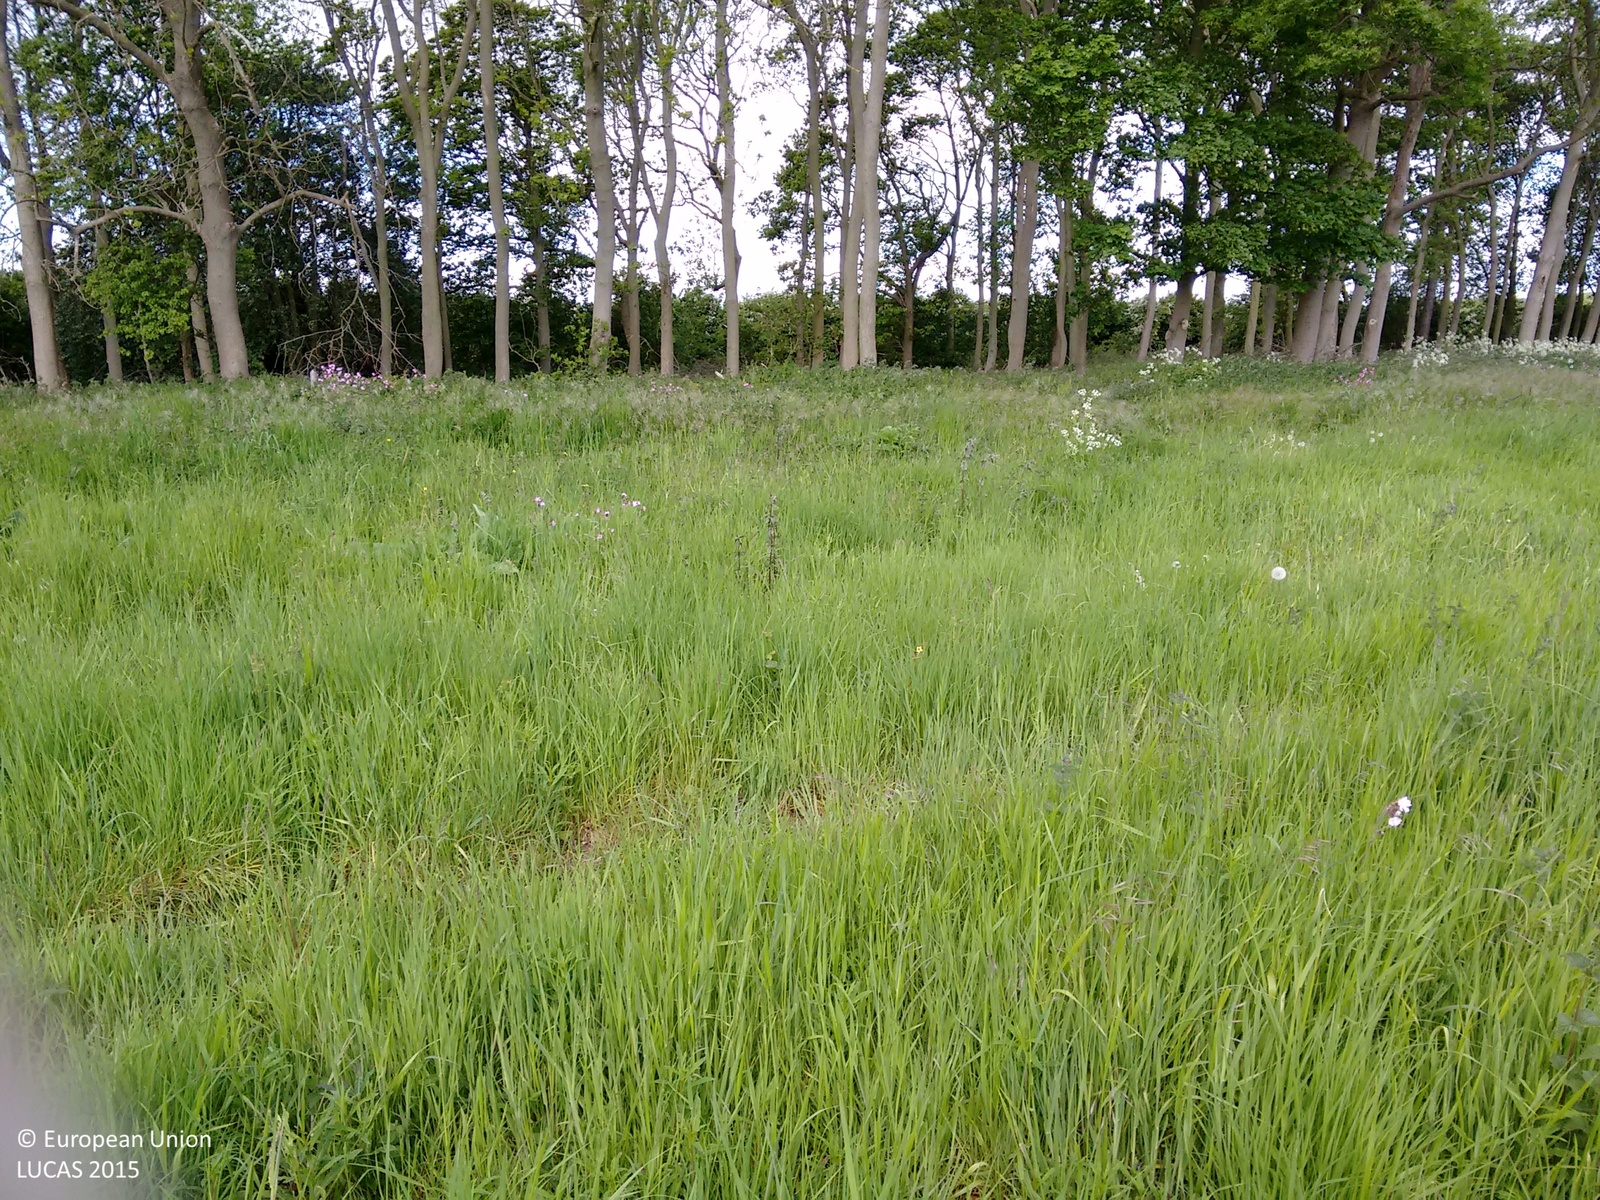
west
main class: Grassland
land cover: Grassland without tree/shrub cover
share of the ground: > 75 %
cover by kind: herbaceous plants 100 %
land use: Agriculture (excluding fallow land and kitchen gardens)
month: May
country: GB
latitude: 53.5458
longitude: -0.2515
